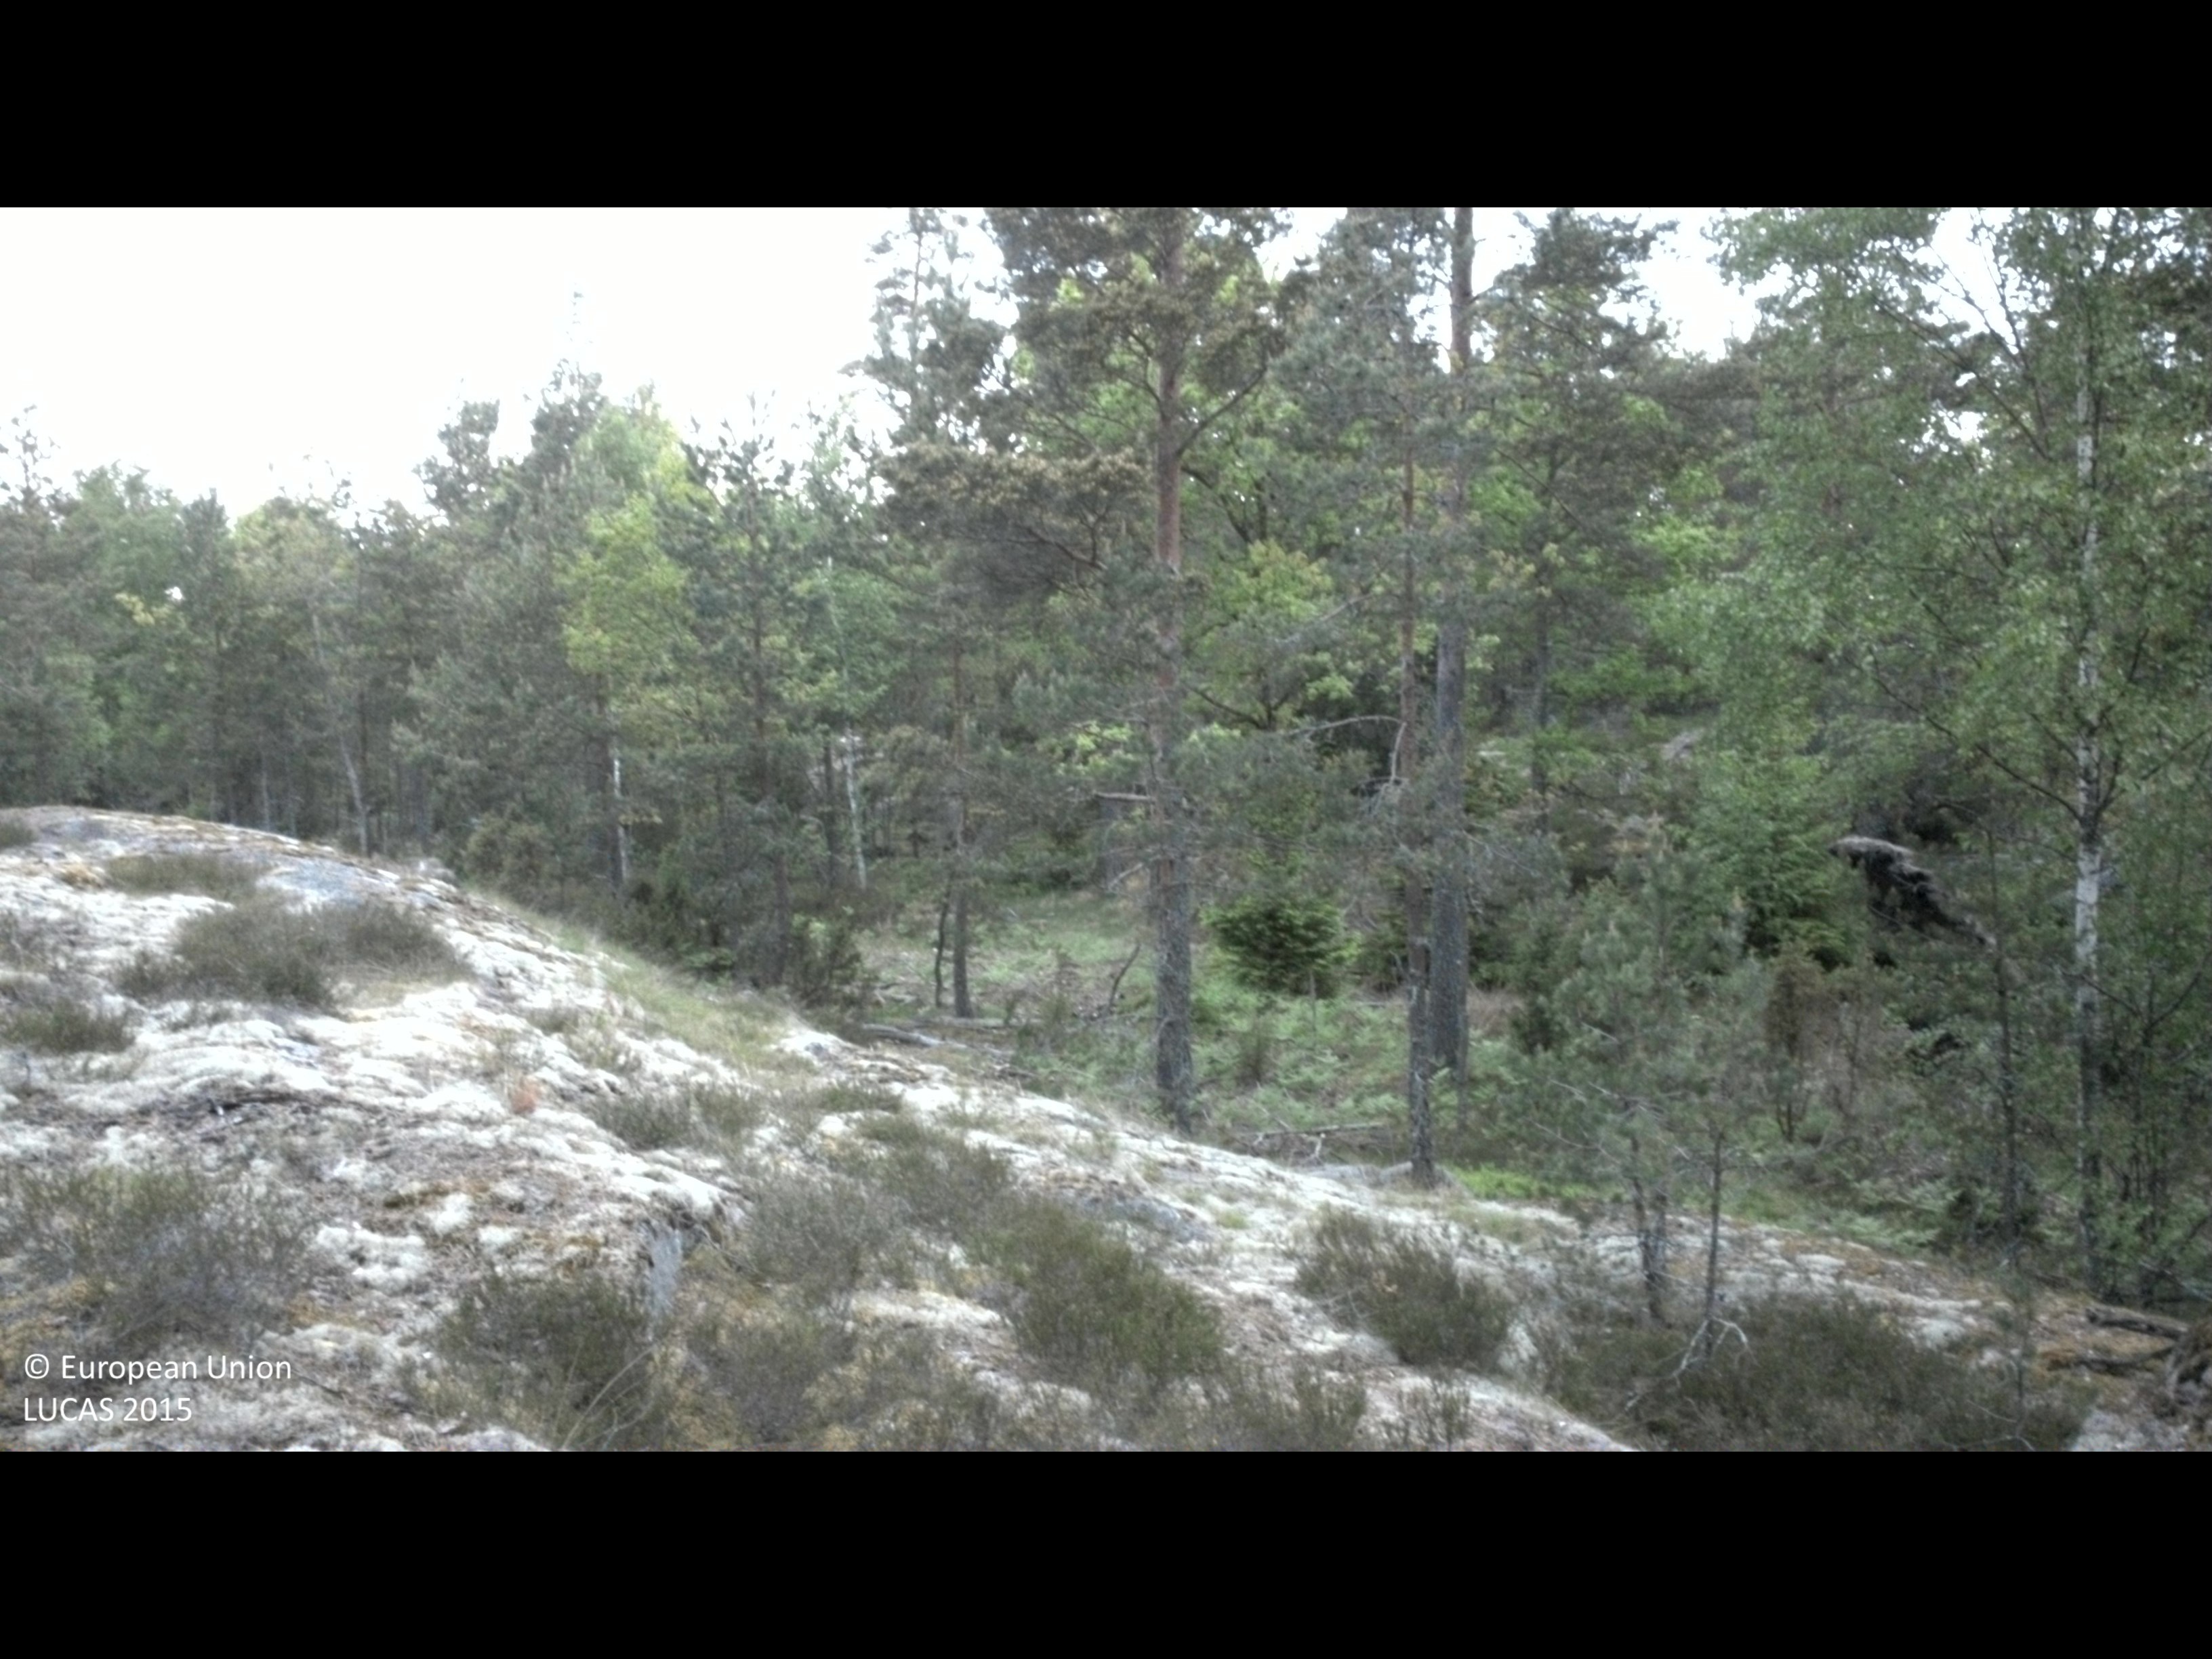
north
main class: Woodland
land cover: Pine dominated coniferous woodland
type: boreal forest
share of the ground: 50 - 75 %
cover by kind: coniferous forest trees 60 %, shrubs 20 %, lichens and mosses 15 %, broadleaved forest trees 5 %
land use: Forestry
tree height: > 5 m
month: May
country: SE
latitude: 57.4770
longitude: 16.6537
